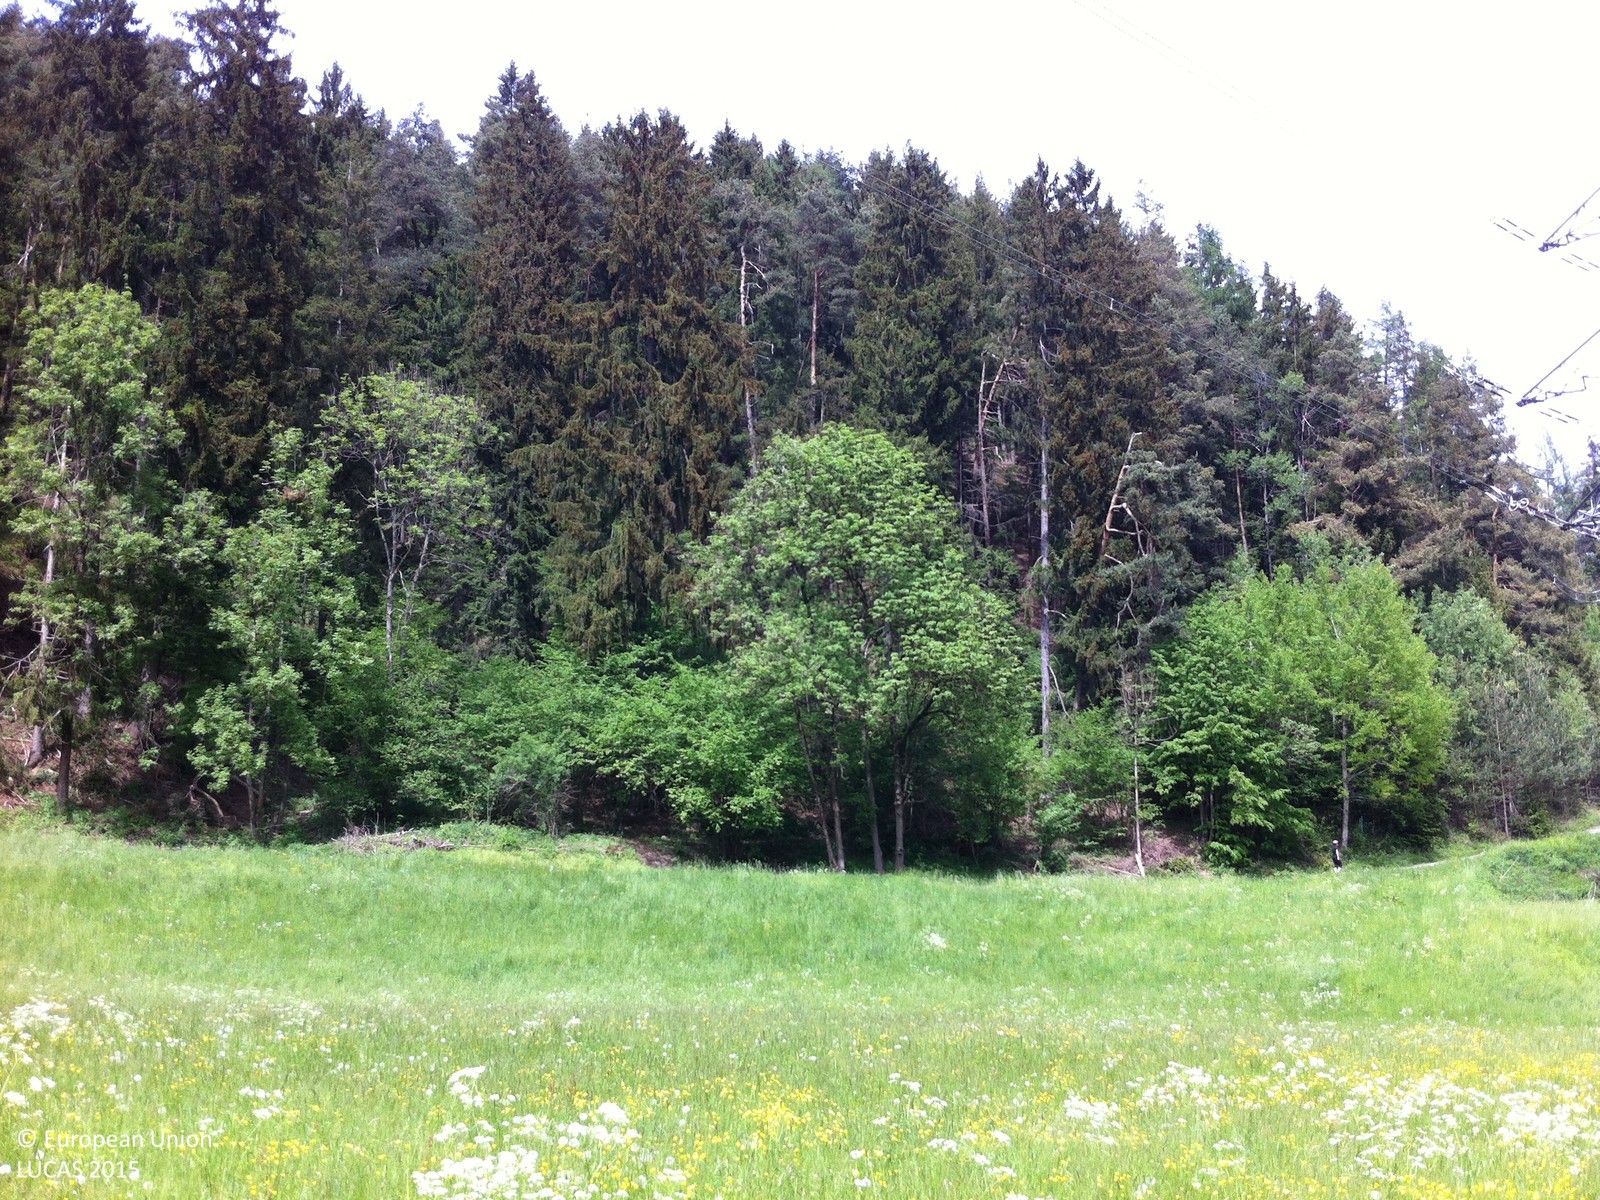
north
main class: Grassland
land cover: Grassland without tree/shrub cover
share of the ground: > 75 %
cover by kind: herbaceous plants 100 %
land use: Agriculture (excluding fallow land and kitchen gardens)
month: May
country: AT
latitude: 47.2437
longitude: 11.3067
